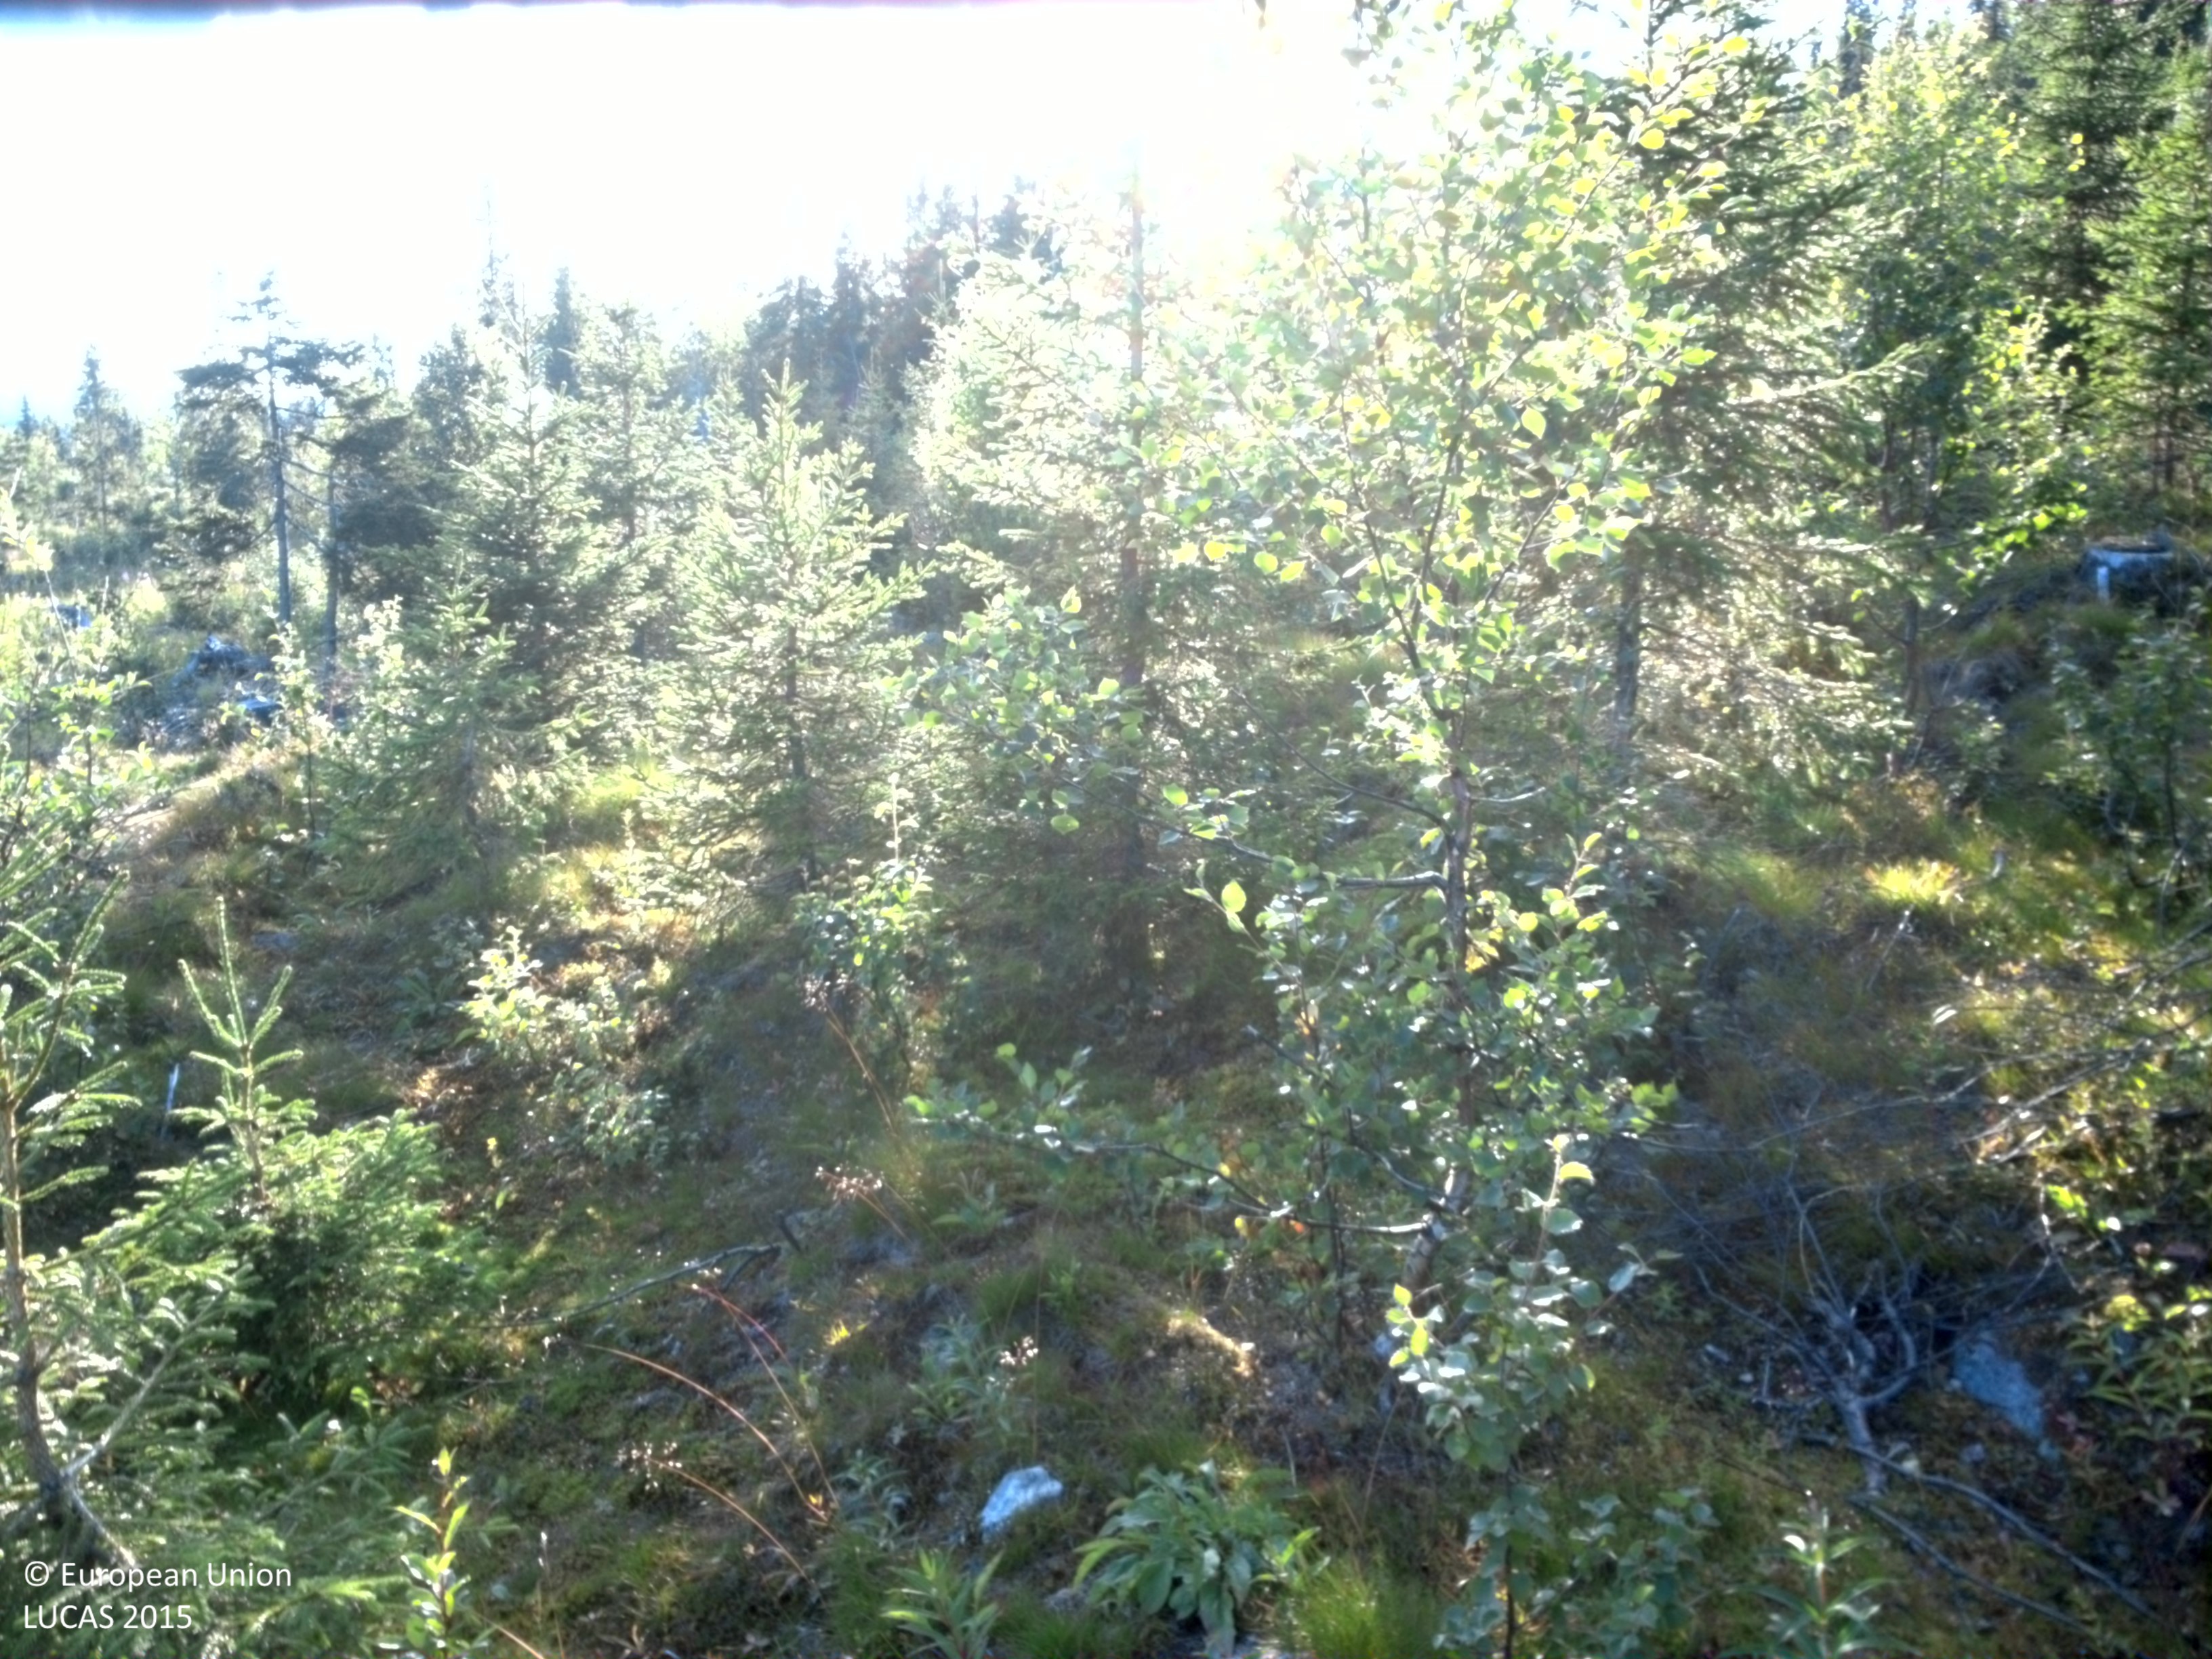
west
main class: Woodland
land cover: Spruce dominated mixed woodland
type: boreal forest
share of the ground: 25 - 50 %
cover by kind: herbaceous plants 55 %, coniferous forest trees 15 %, lichens and mosses 15 %, broadleaved forest trees 10 %, shrubs 5 %
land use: Forestry
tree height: < 5 m
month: August
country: SE
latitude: 64.9087
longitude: 15.7791
